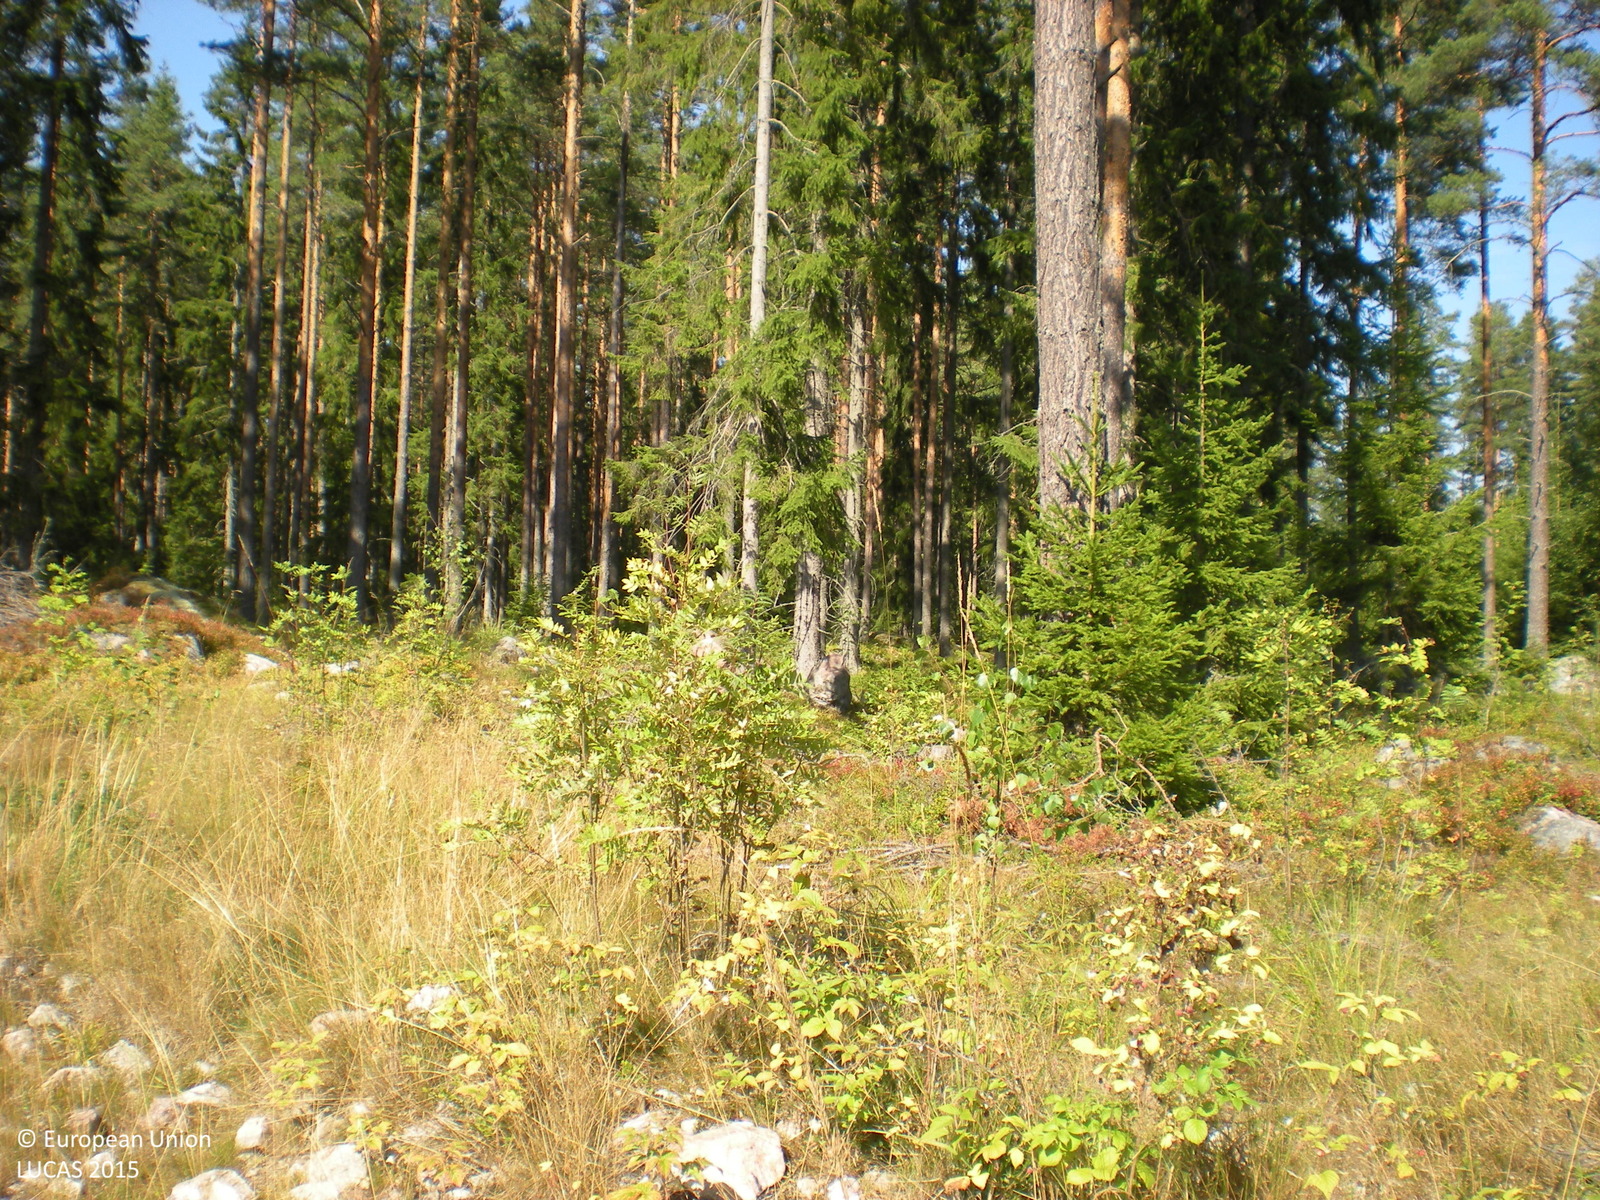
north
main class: Shrubland
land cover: Shrubland with sparse tree cover
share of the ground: 50 - 75 %
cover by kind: shrubs 60 %, unconsolidated bare surface 15 %, herbaceous plants 10 %, consolidated bare surface 10 %, broadleaved forest trees 5 %
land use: Forestry
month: August
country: SE
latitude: 60.6257
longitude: 17.2819
